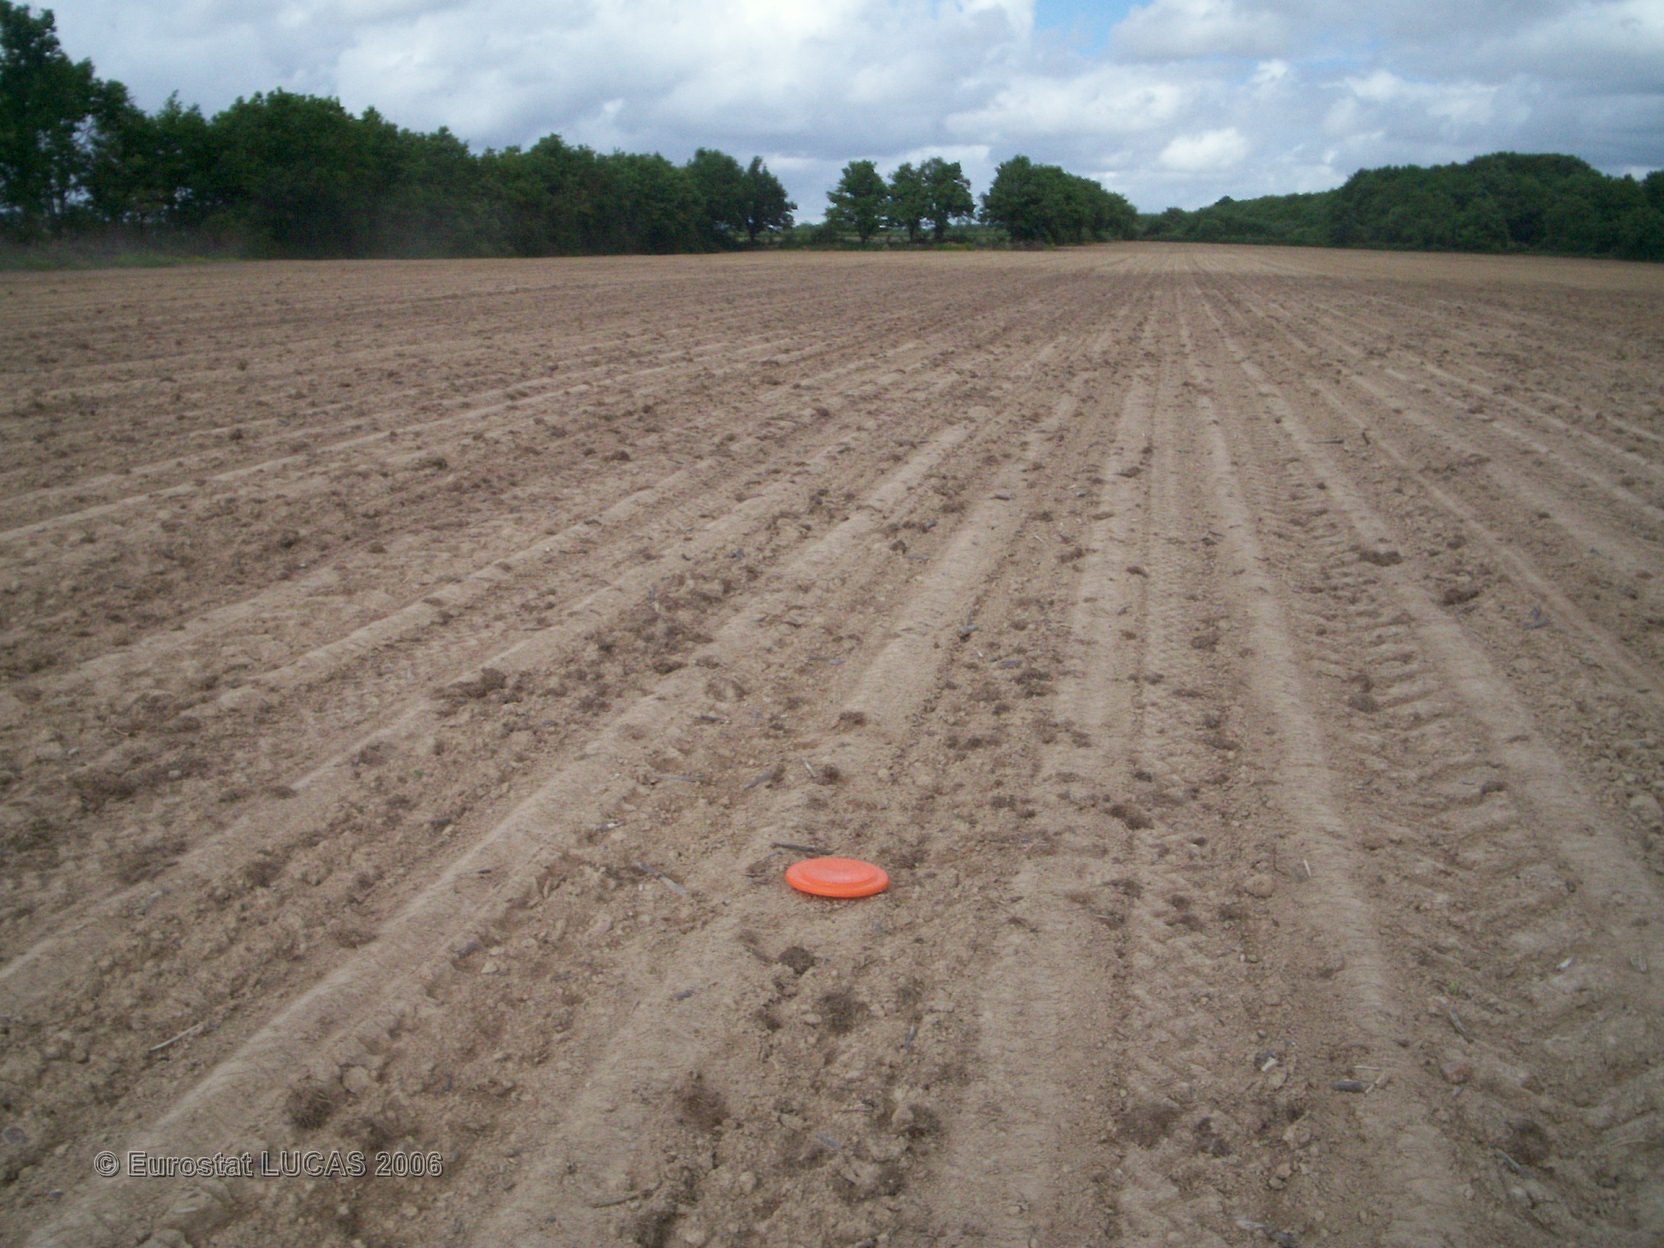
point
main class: Cropland
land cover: Sunflower
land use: Agriculture (excluding fallow land and kitchen gardens)
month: May
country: FR
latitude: 46.5611
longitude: -0.8446
